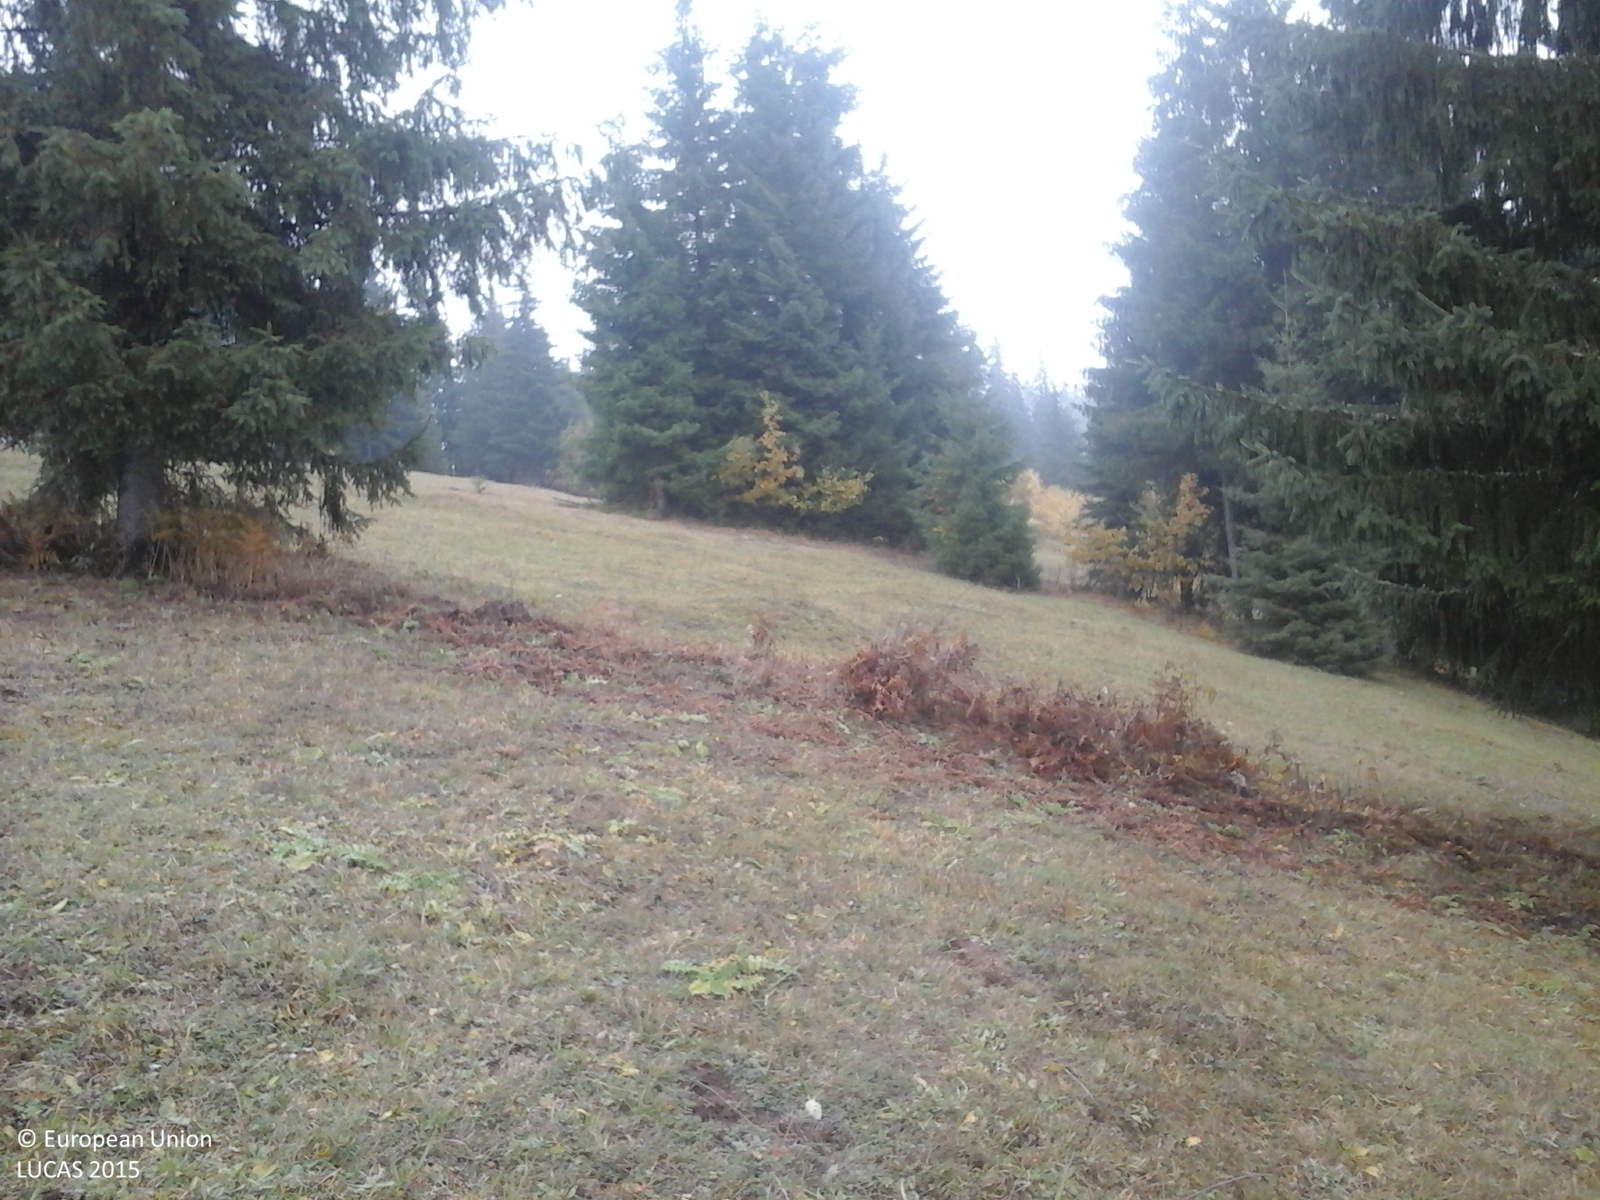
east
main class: Grassland
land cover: Grassland without tree/shrub cover
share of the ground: > 75 %
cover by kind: herbaceous plants 100 %
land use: Agriculture (excluding fallow land and kitchen gardens)
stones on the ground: < 10 %
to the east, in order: Grassland without tree/shrub cover; Broadleaved woodland; Grassland without tree/shrub cover; Fences; Lines of trees; Tracks; Lines of trees; Grassland without tree/shrub cover; Grassland with sparse tree/shrub cover
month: October
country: RO
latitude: 46.5505
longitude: 25.9938
